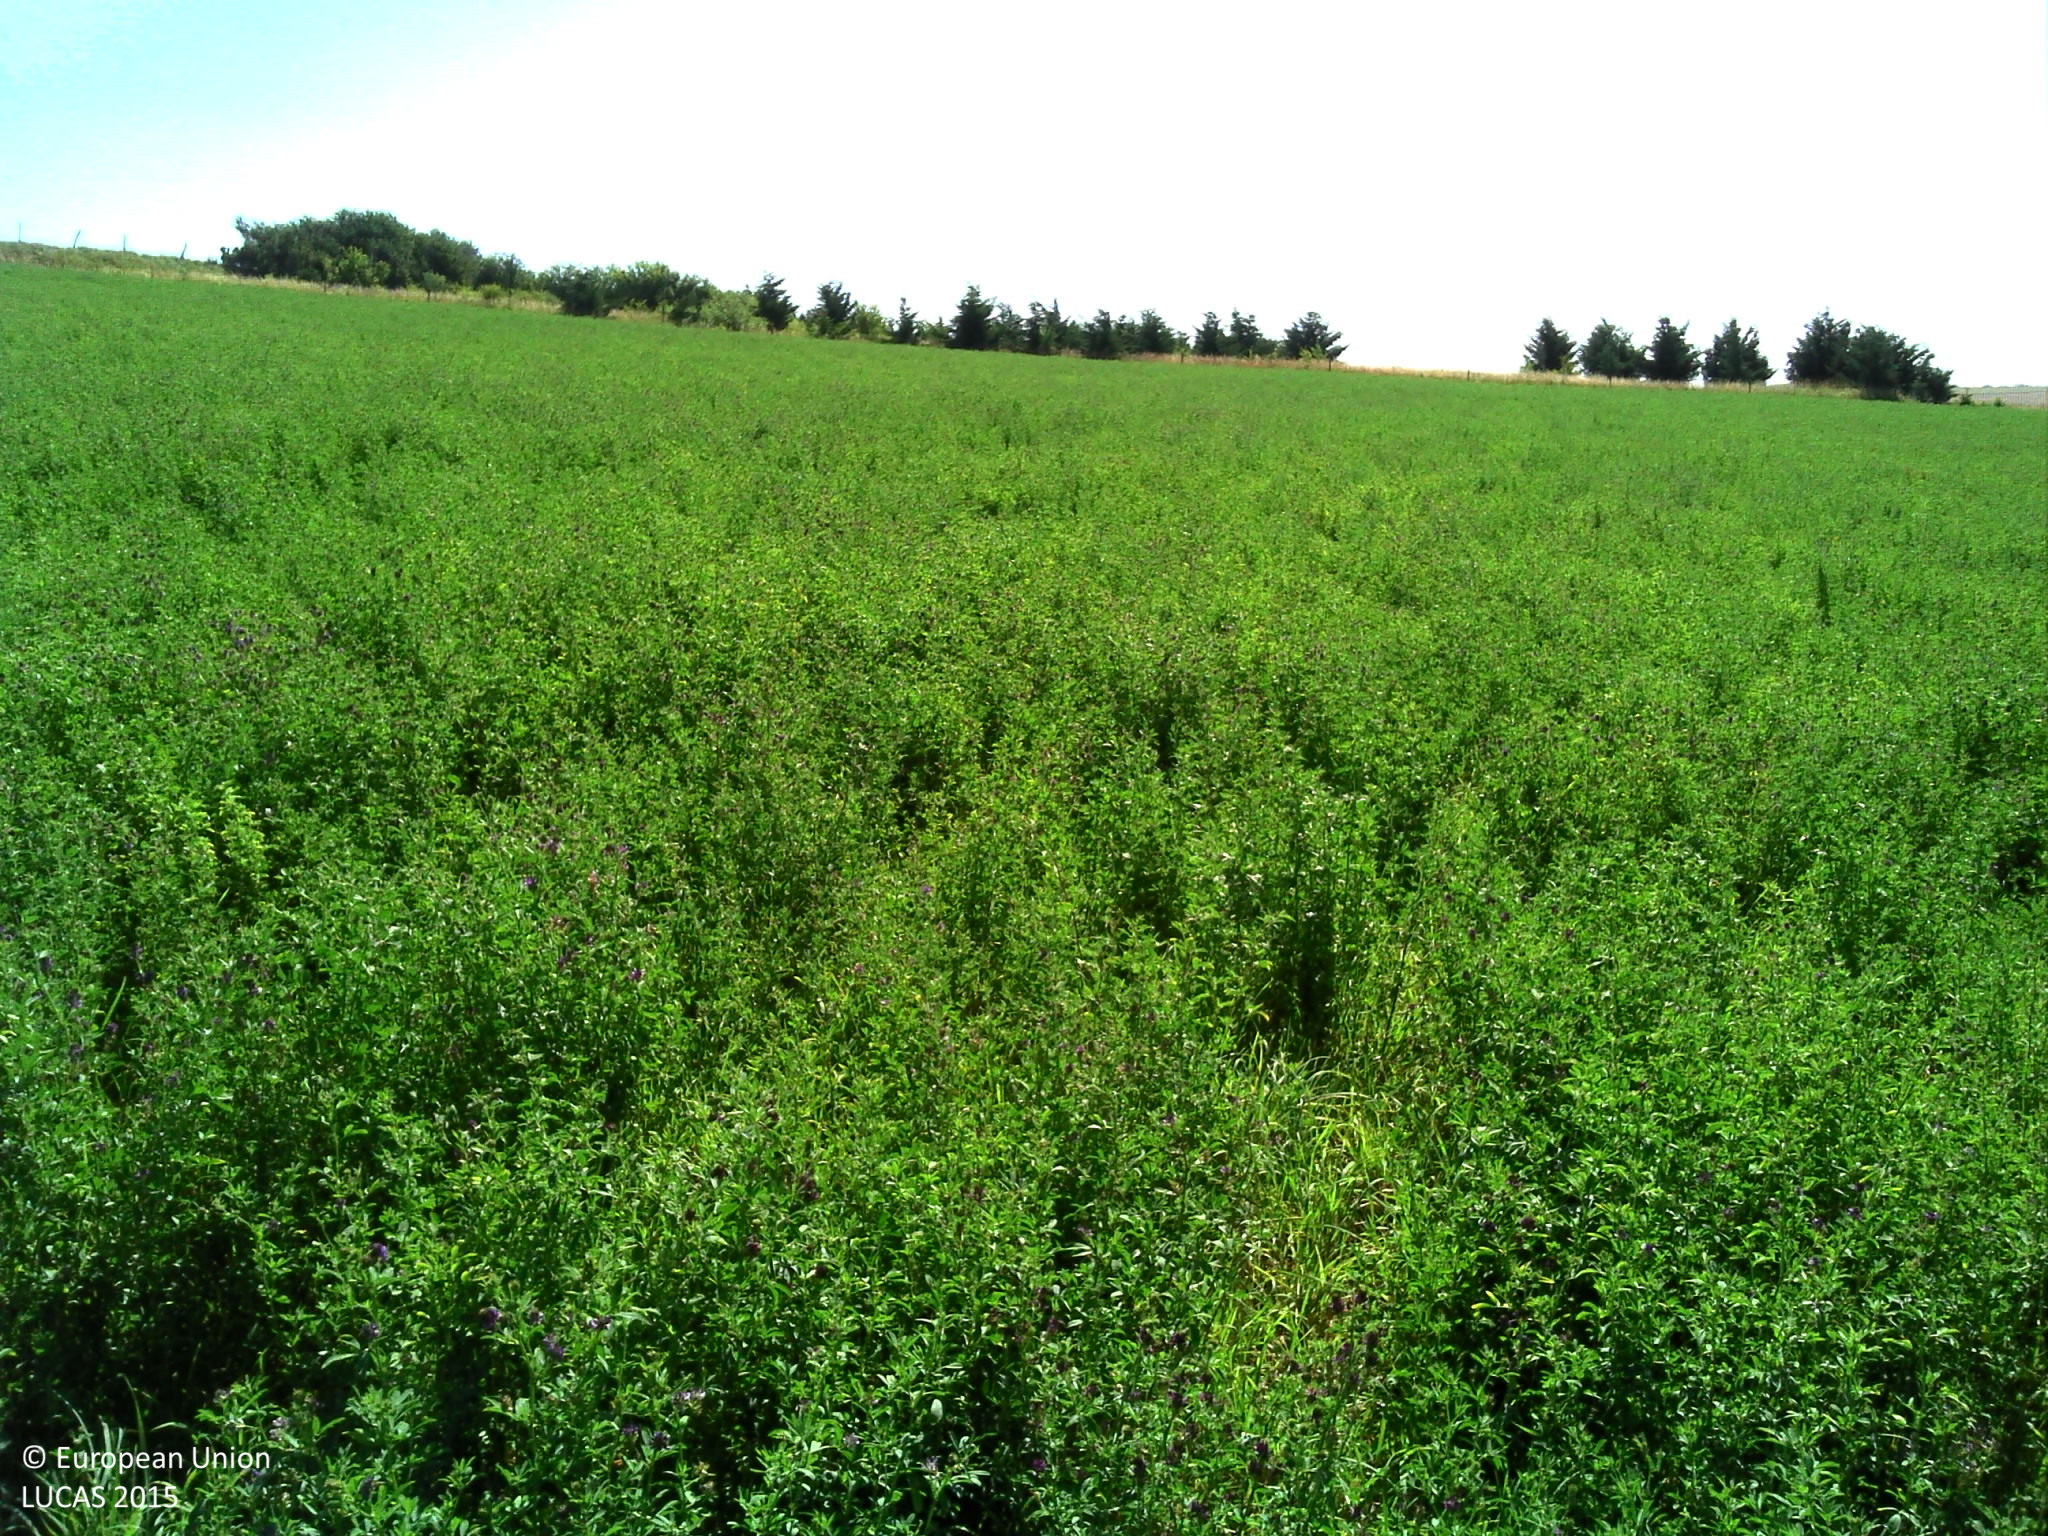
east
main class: Cropland
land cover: Lucerne
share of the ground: > 75 %
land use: Agriculture (excluding fallow land and kitchen gardens)
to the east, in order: Lucerne; Fences; Other coniferous woodland; Spontaneously vegetated surfaces; Lines of trees; Fences; Grass margins; Barley
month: July
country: FR
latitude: 50.2225
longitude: 2.1786
